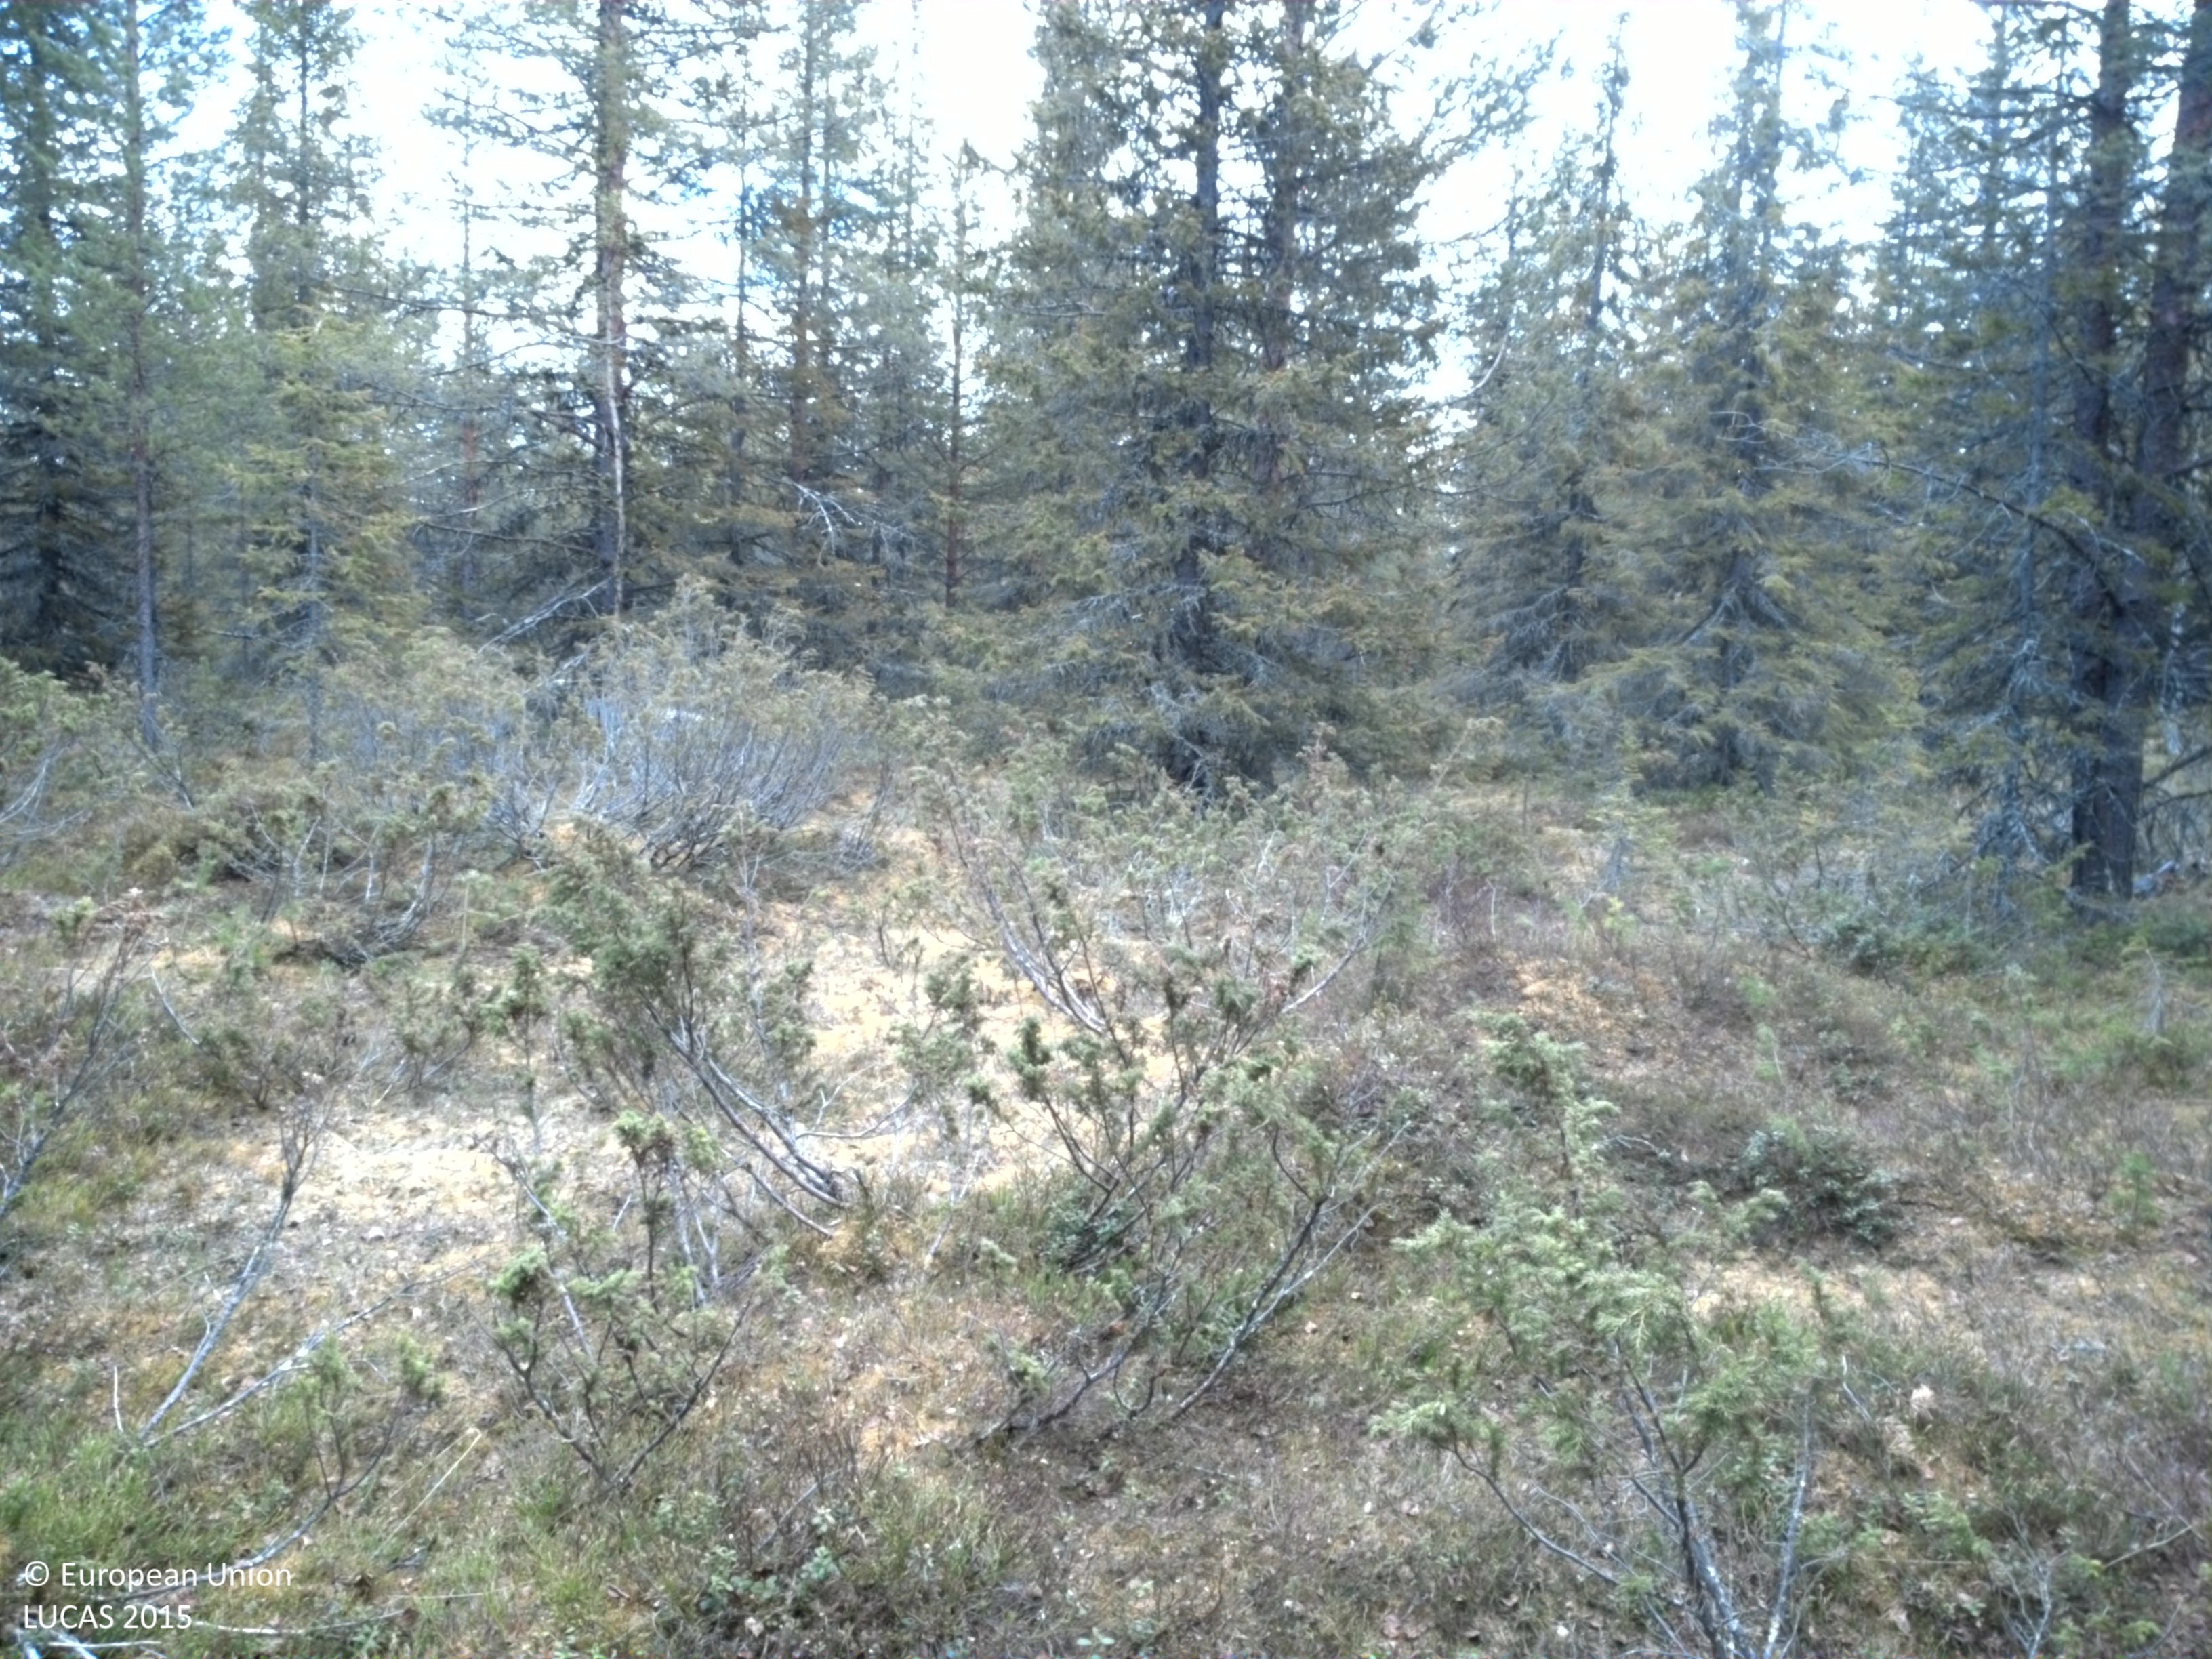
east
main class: Woodland
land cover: Other coniferous woodland
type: boreal forest
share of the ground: 50 - 75 %
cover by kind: coniferous forest trees 50 %, shrubs 45 %, broadleaved forest trees 5 %
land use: Forestry
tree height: > 5 m
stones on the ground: > 50 %
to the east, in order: Other coniferous woodland; Pine dominated coniferous woodland; Peatbogs; Pine dominated coniferous woodland
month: June
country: SE
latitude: 66.1070
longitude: 18.6947
